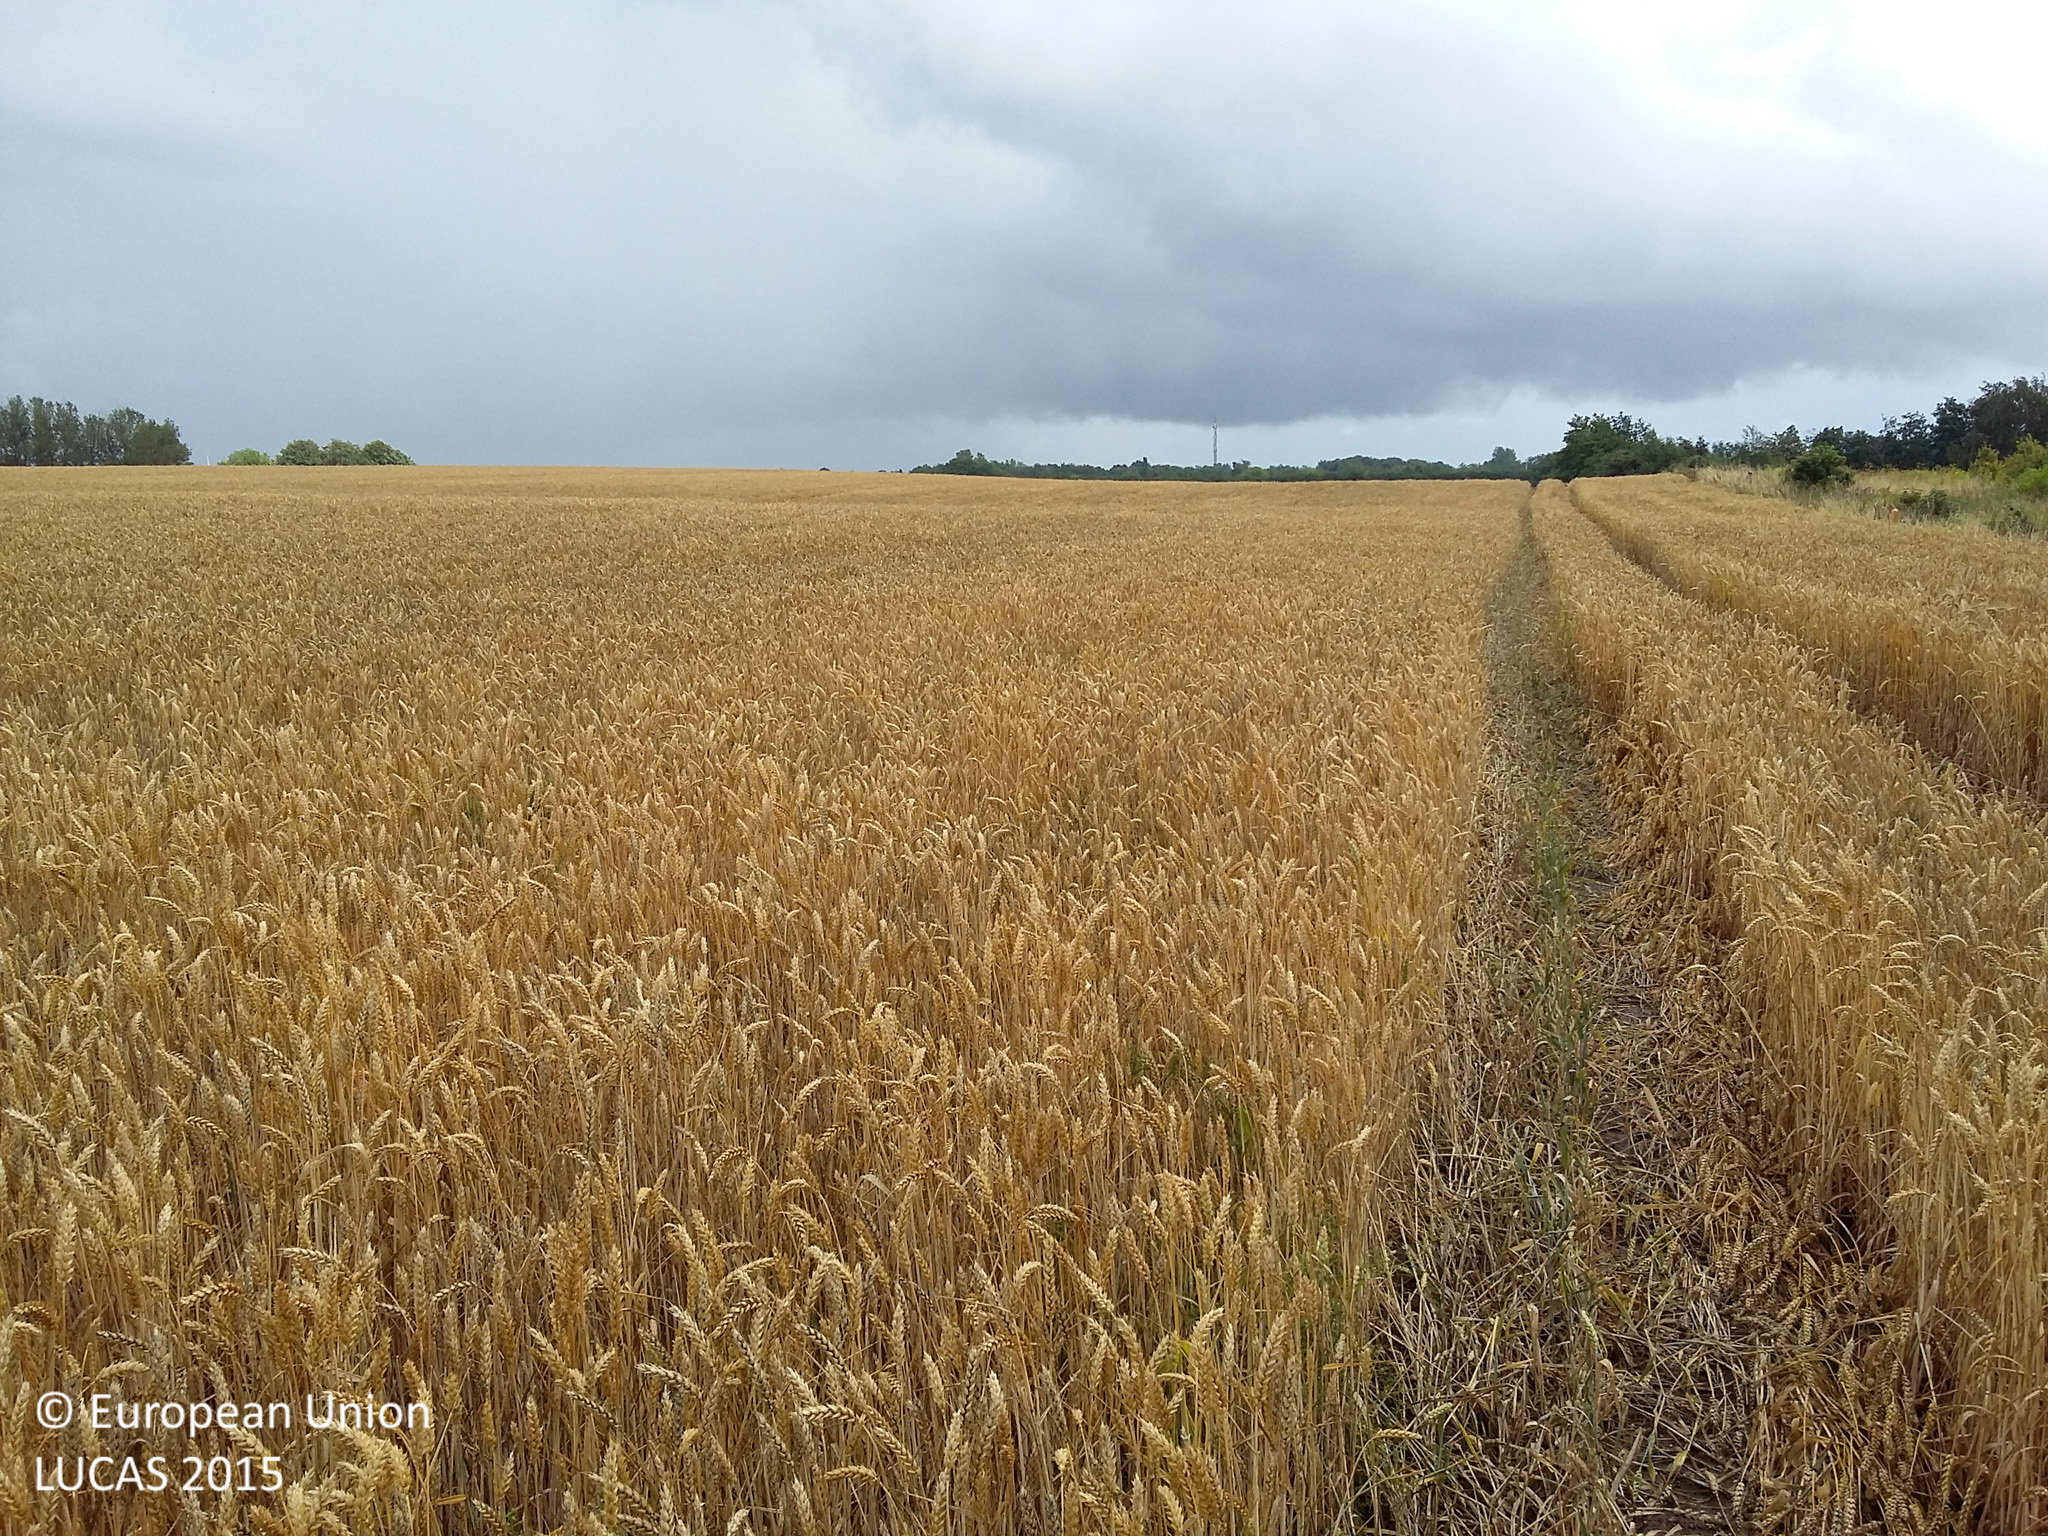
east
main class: Cropland
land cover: Common wheat
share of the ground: > 75 %
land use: Agriculture (excluding fallow land and kitchen gardens)
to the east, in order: Common wheat
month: July
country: DK
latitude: 55.7741
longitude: 12.1502
